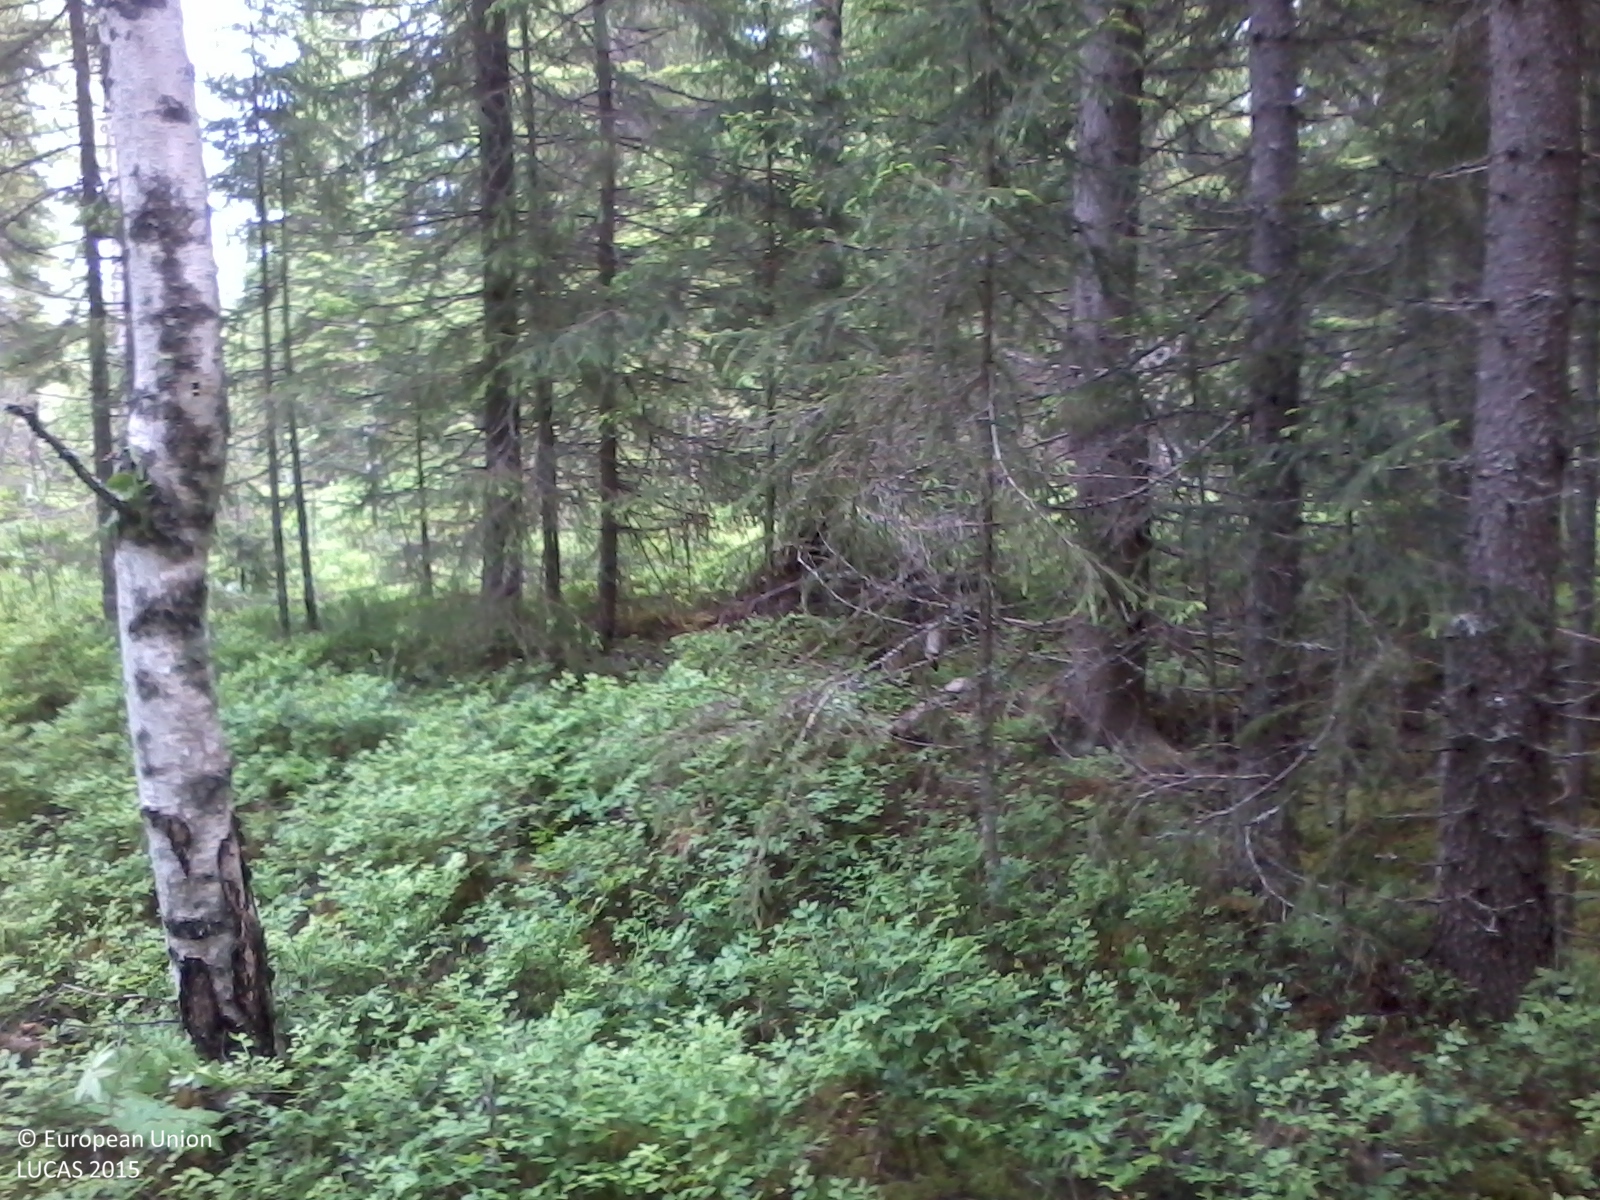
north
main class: Woodland
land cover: Spruce dominated mixed woodland
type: boreal forest
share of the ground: 50 - 75 %
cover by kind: coniferous forest trees 50 %, shrubs 30 %, broadleaved forest trees 20 %
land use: Forestry
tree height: > 5 m
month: June
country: SE
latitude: 63.4688
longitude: 18.0215
